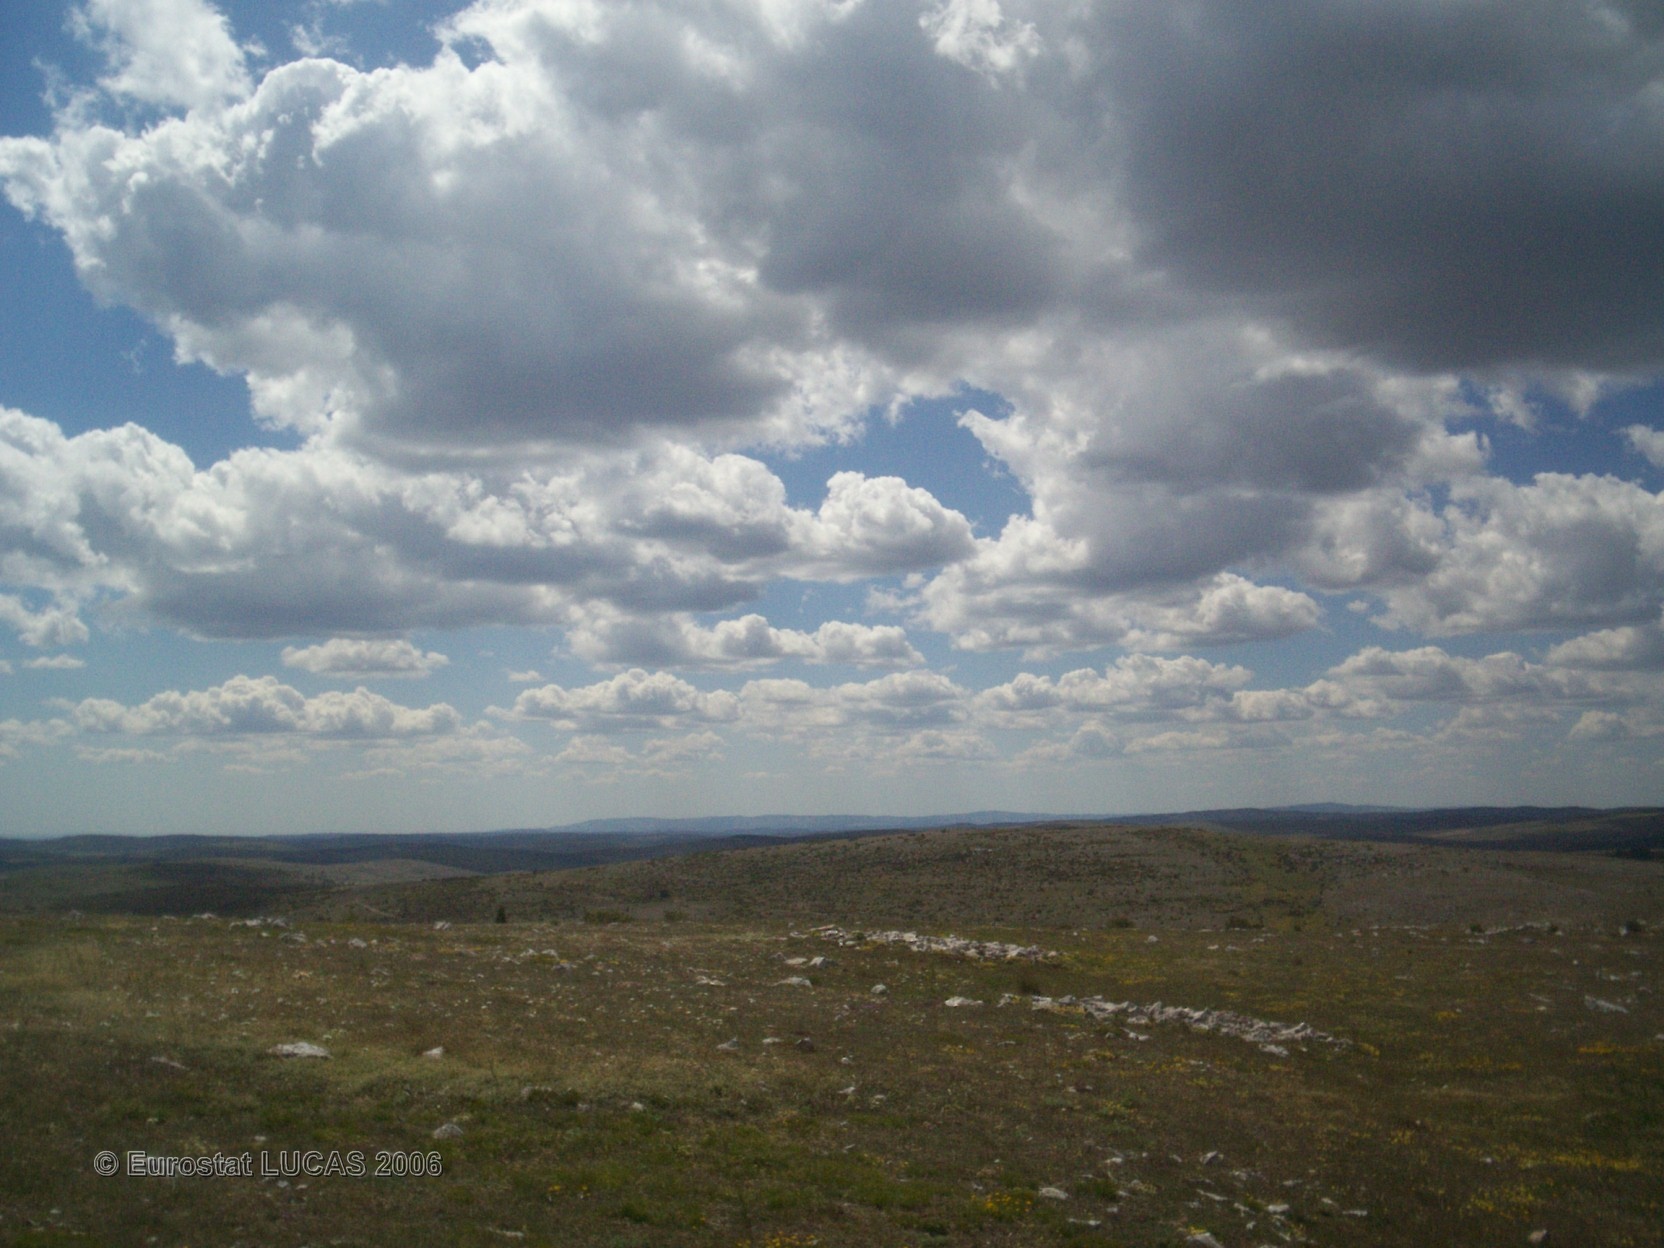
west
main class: Grassland
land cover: Grassland without tree/shrub cover
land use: Agriculture (excluding fallow land and kitchen gardens)
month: June
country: FR
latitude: 44.2165
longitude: 3.4601
